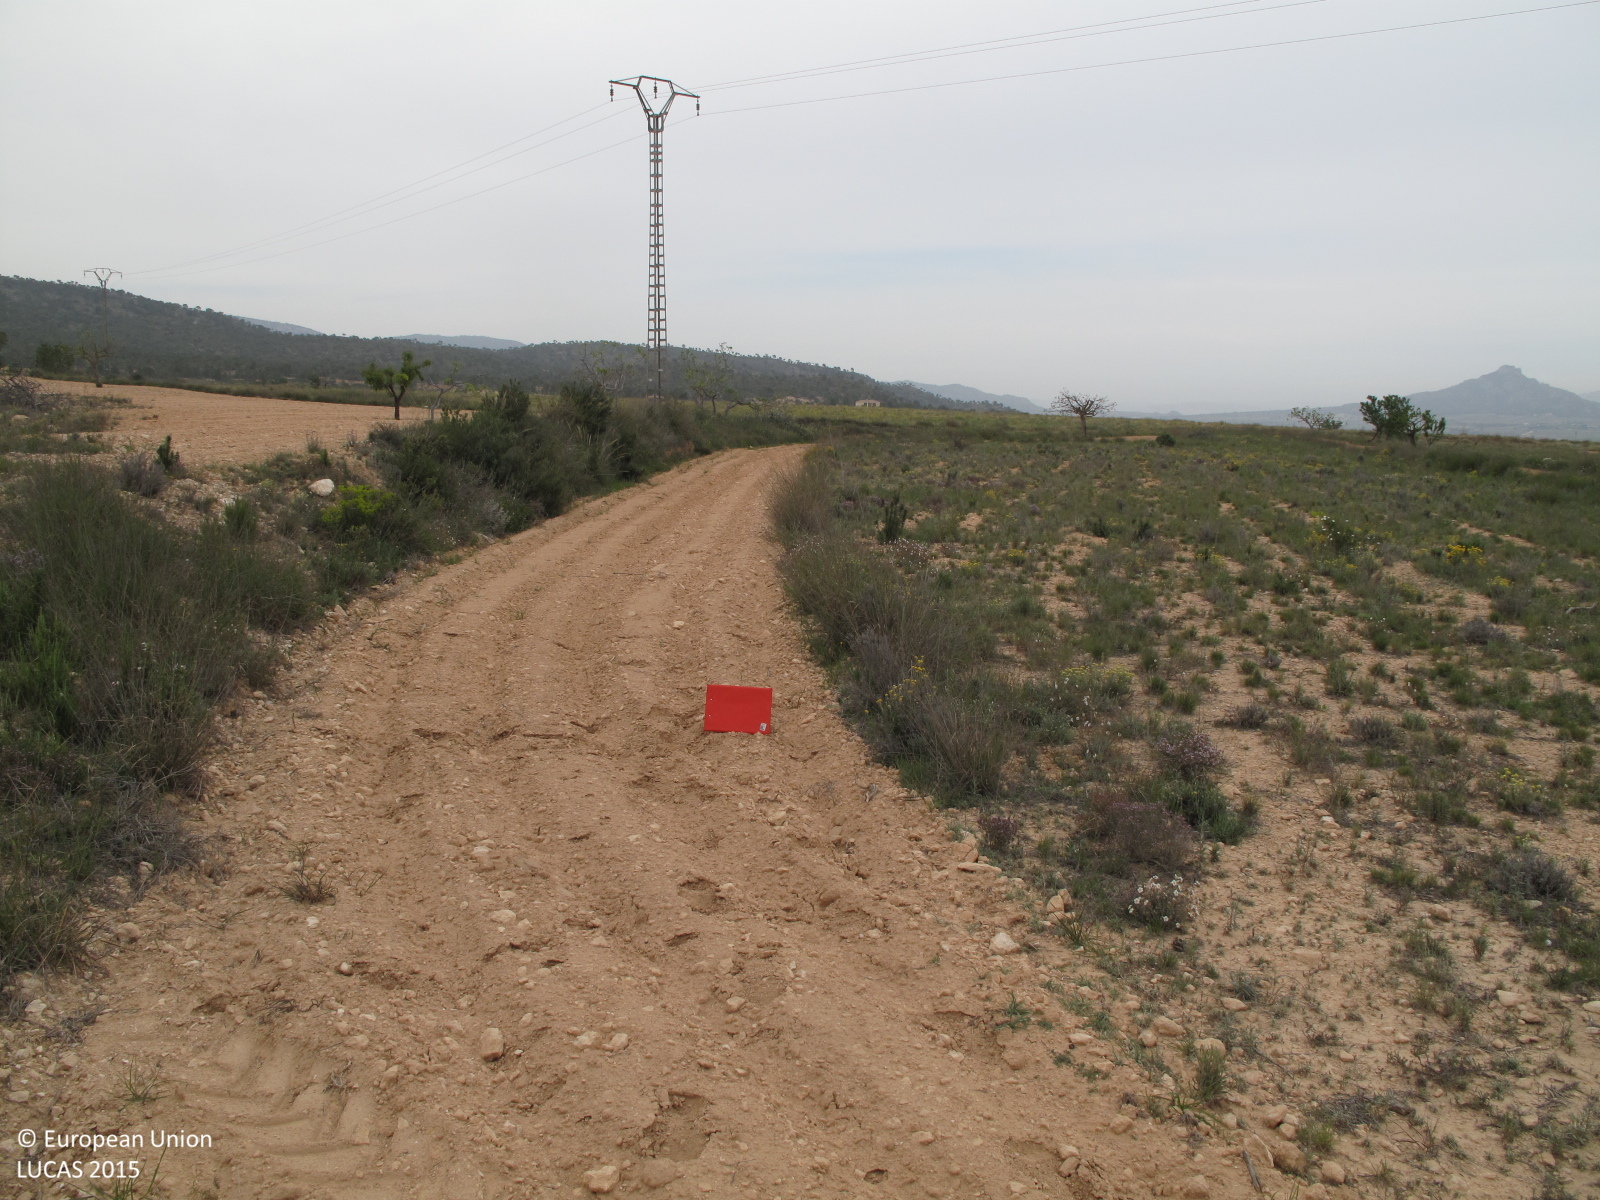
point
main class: Grassland
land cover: Spontaneously vegetated surfaces
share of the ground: 25 - 50 %
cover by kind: consolidated bare surface 55 %, herbaceous plants 45 %
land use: Fallow land
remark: Fire break
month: April
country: ES
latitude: 38.4703
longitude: -0.9116
